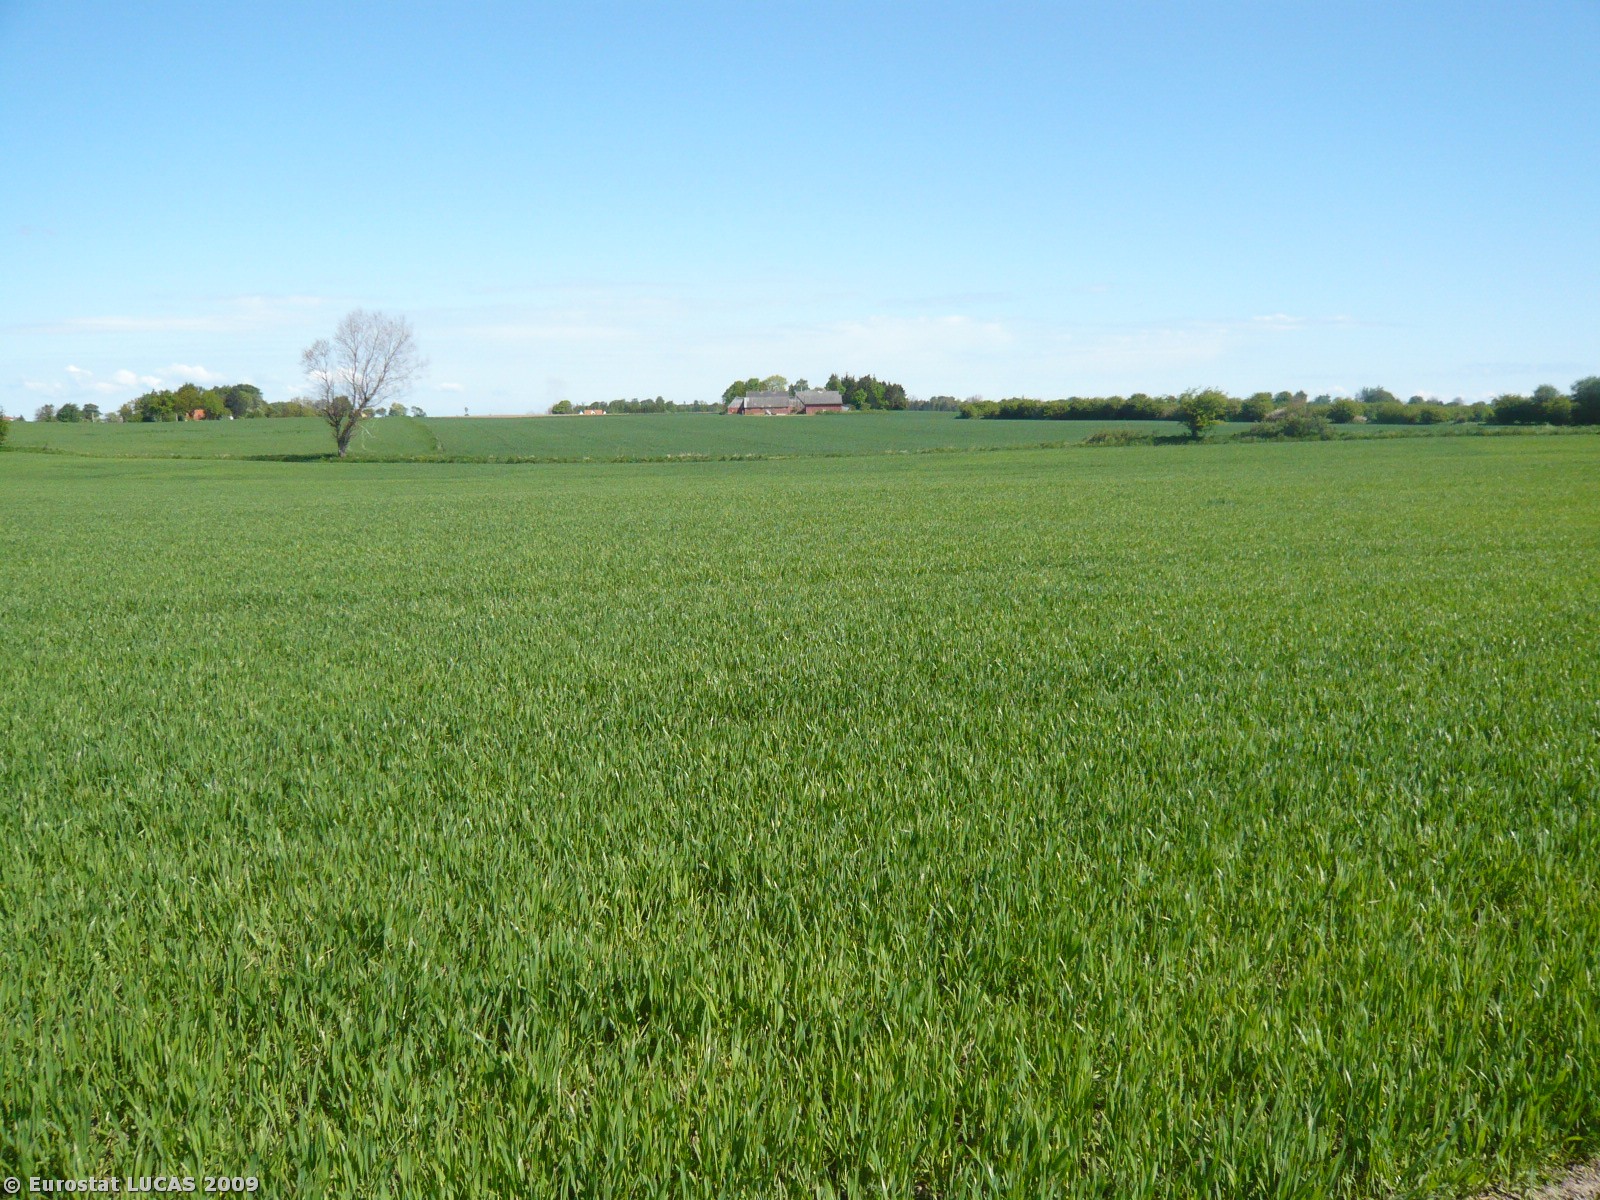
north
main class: Cropland
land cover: Common wheat
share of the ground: > 75 %
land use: Agriculture (excluding fallow land and kitchen gardens)
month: May
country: DK
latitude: 55.0746
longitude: 12.0503
